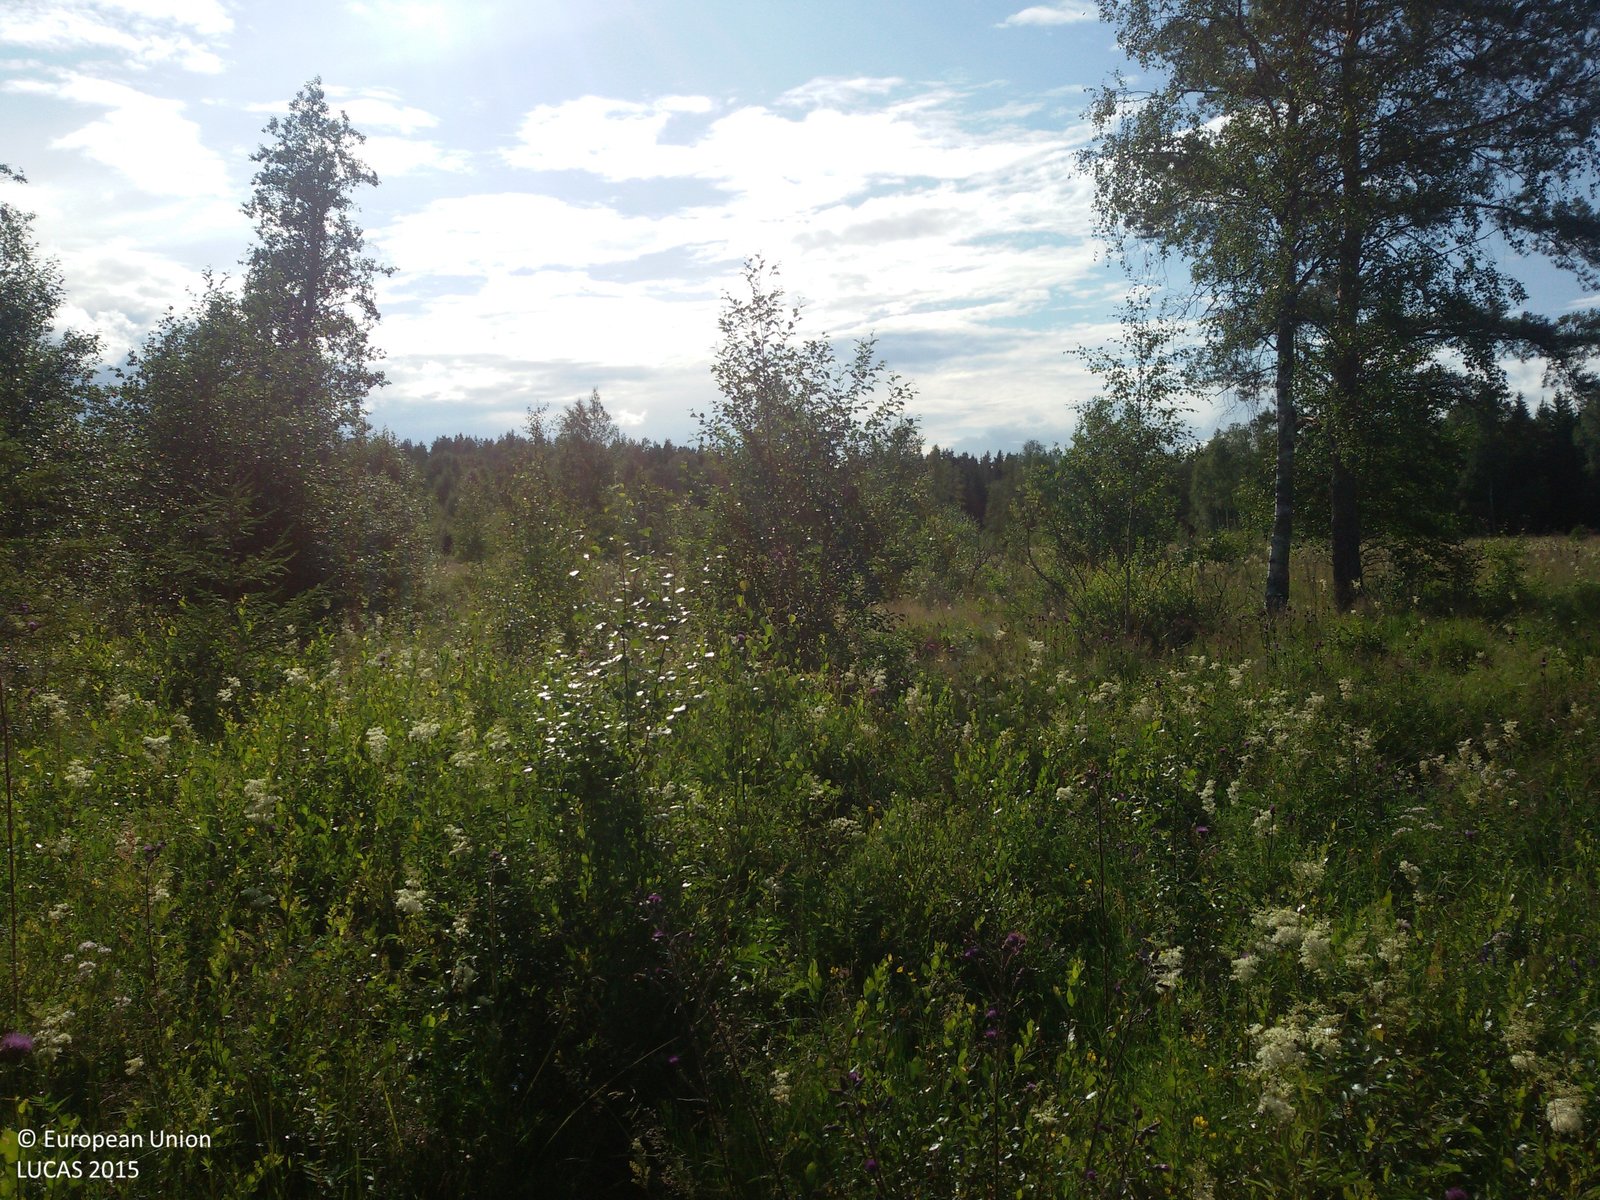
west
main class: Grassland
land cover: Grassland without tree/shrub cover
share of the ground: > 75 %
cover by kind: herbaceous plants 100 %
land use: Agriculture (excluding fallow land and kitchen gardens)
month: July
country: SE
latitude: 60.6341
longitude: 14.9781
